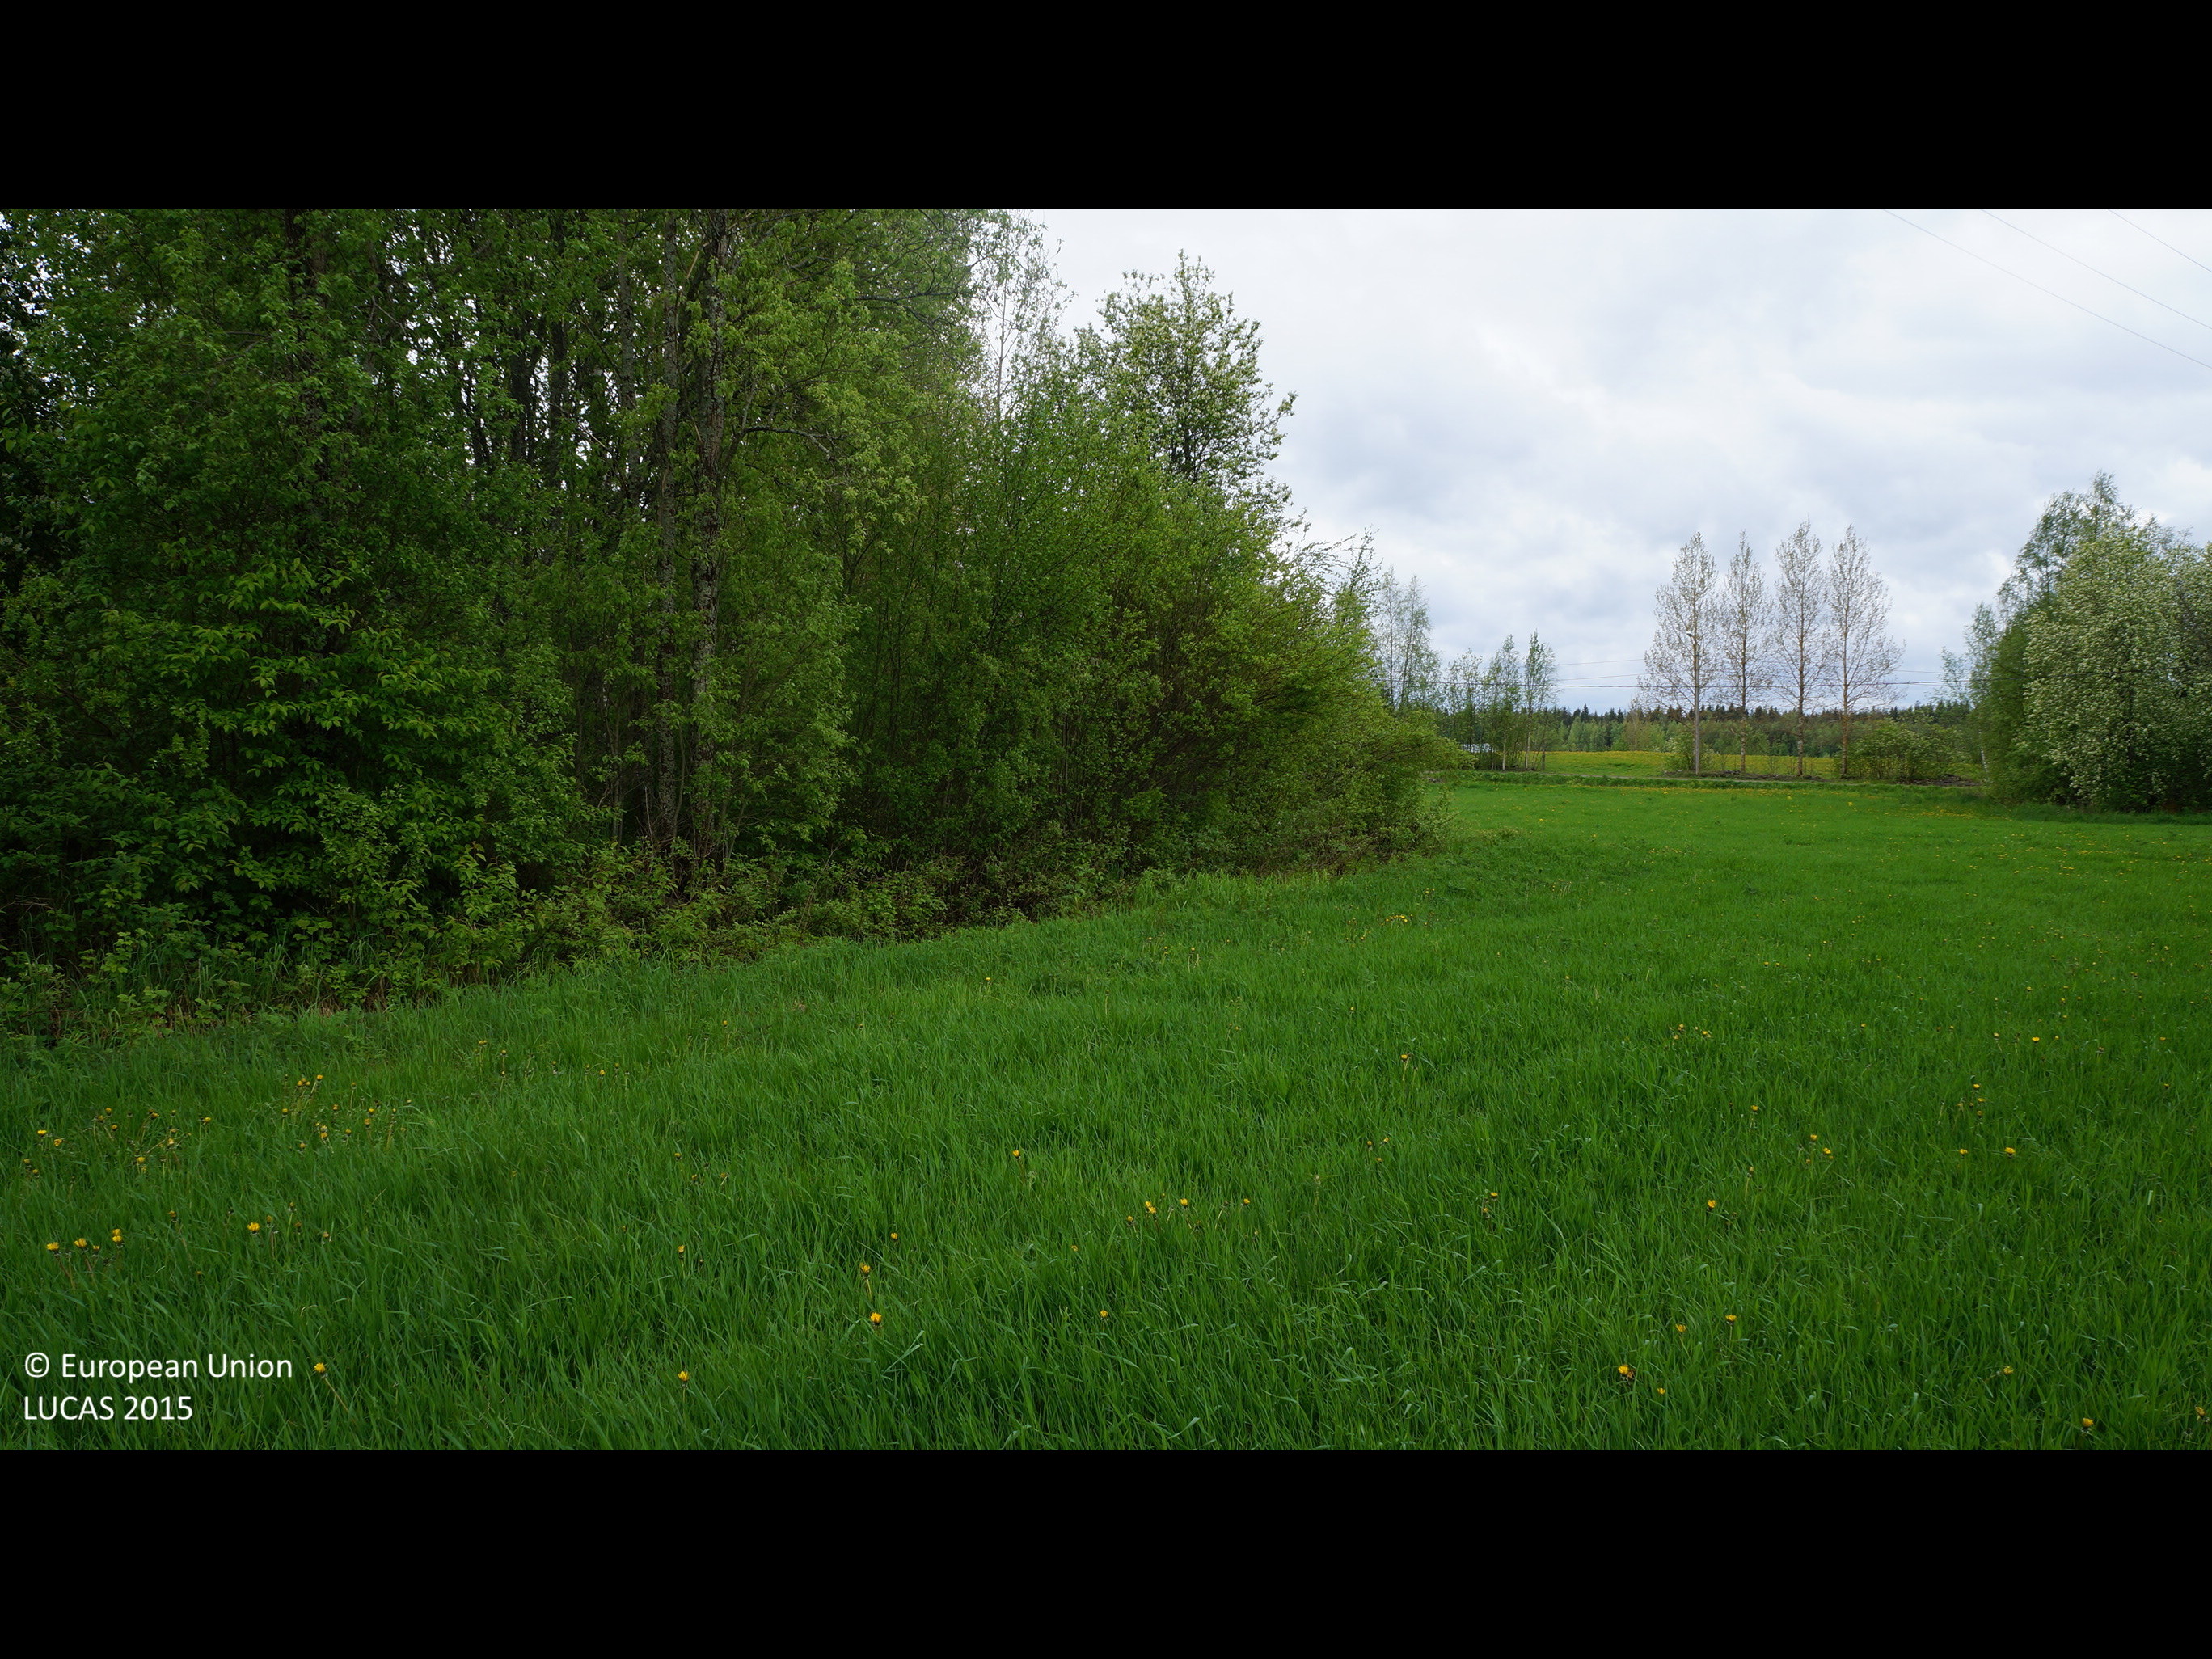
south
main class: Cropland
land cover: Temporary grasslands
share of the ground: > 75 %
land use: Agriculture (excluding fallow land and kitchen gardens)
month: June
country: FI
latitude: 63.8119
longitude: 23.3594
